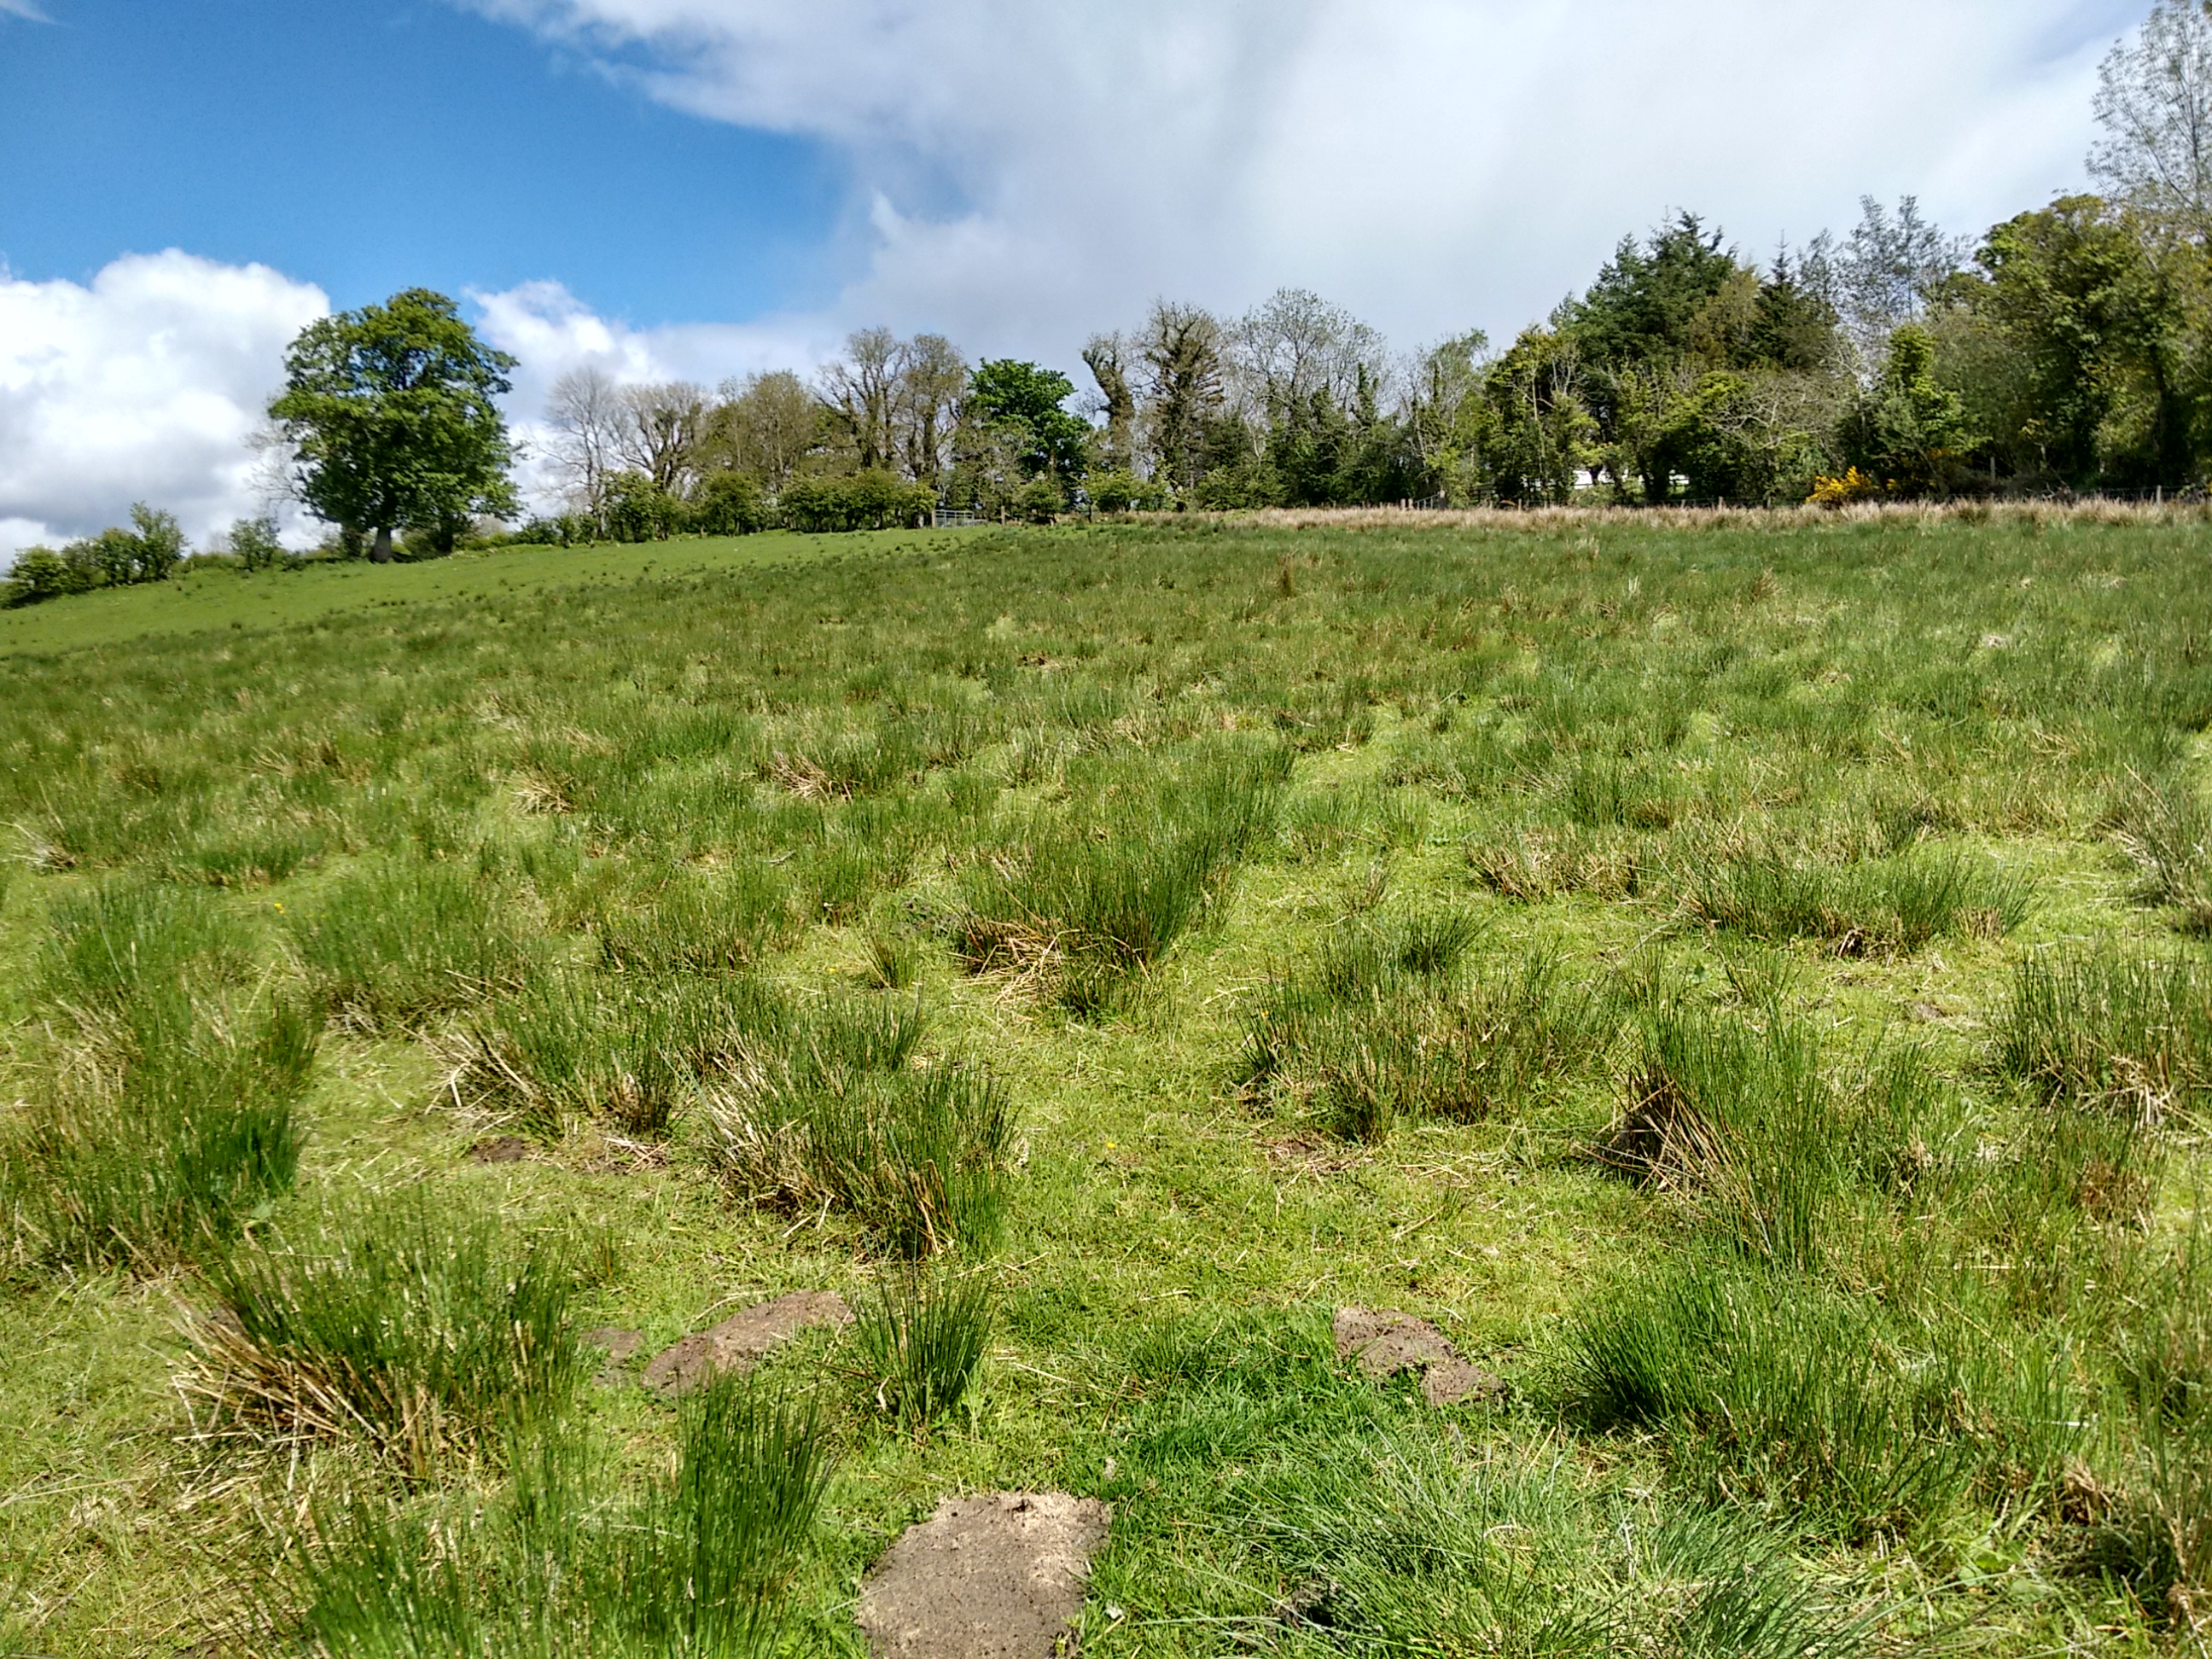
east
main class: Grassland
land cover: Grassland without tree/shrub cover
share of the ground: > 75 %
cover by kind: herbaceous plants 100 %
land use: Agriculture (excluding fallow land and kitchen gardens)
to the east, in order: Managed hedges; Fences; Grassland without tree/shrub cover; Fences; Ditches and canals; Abandoned hedges; Fences; Artificial constructions in urban areas; Grassland without tree/shrub cover; Electric lines; Grassland without tree/shrub cover
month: May
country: GB
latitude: 54.9119
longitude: -7.1294
